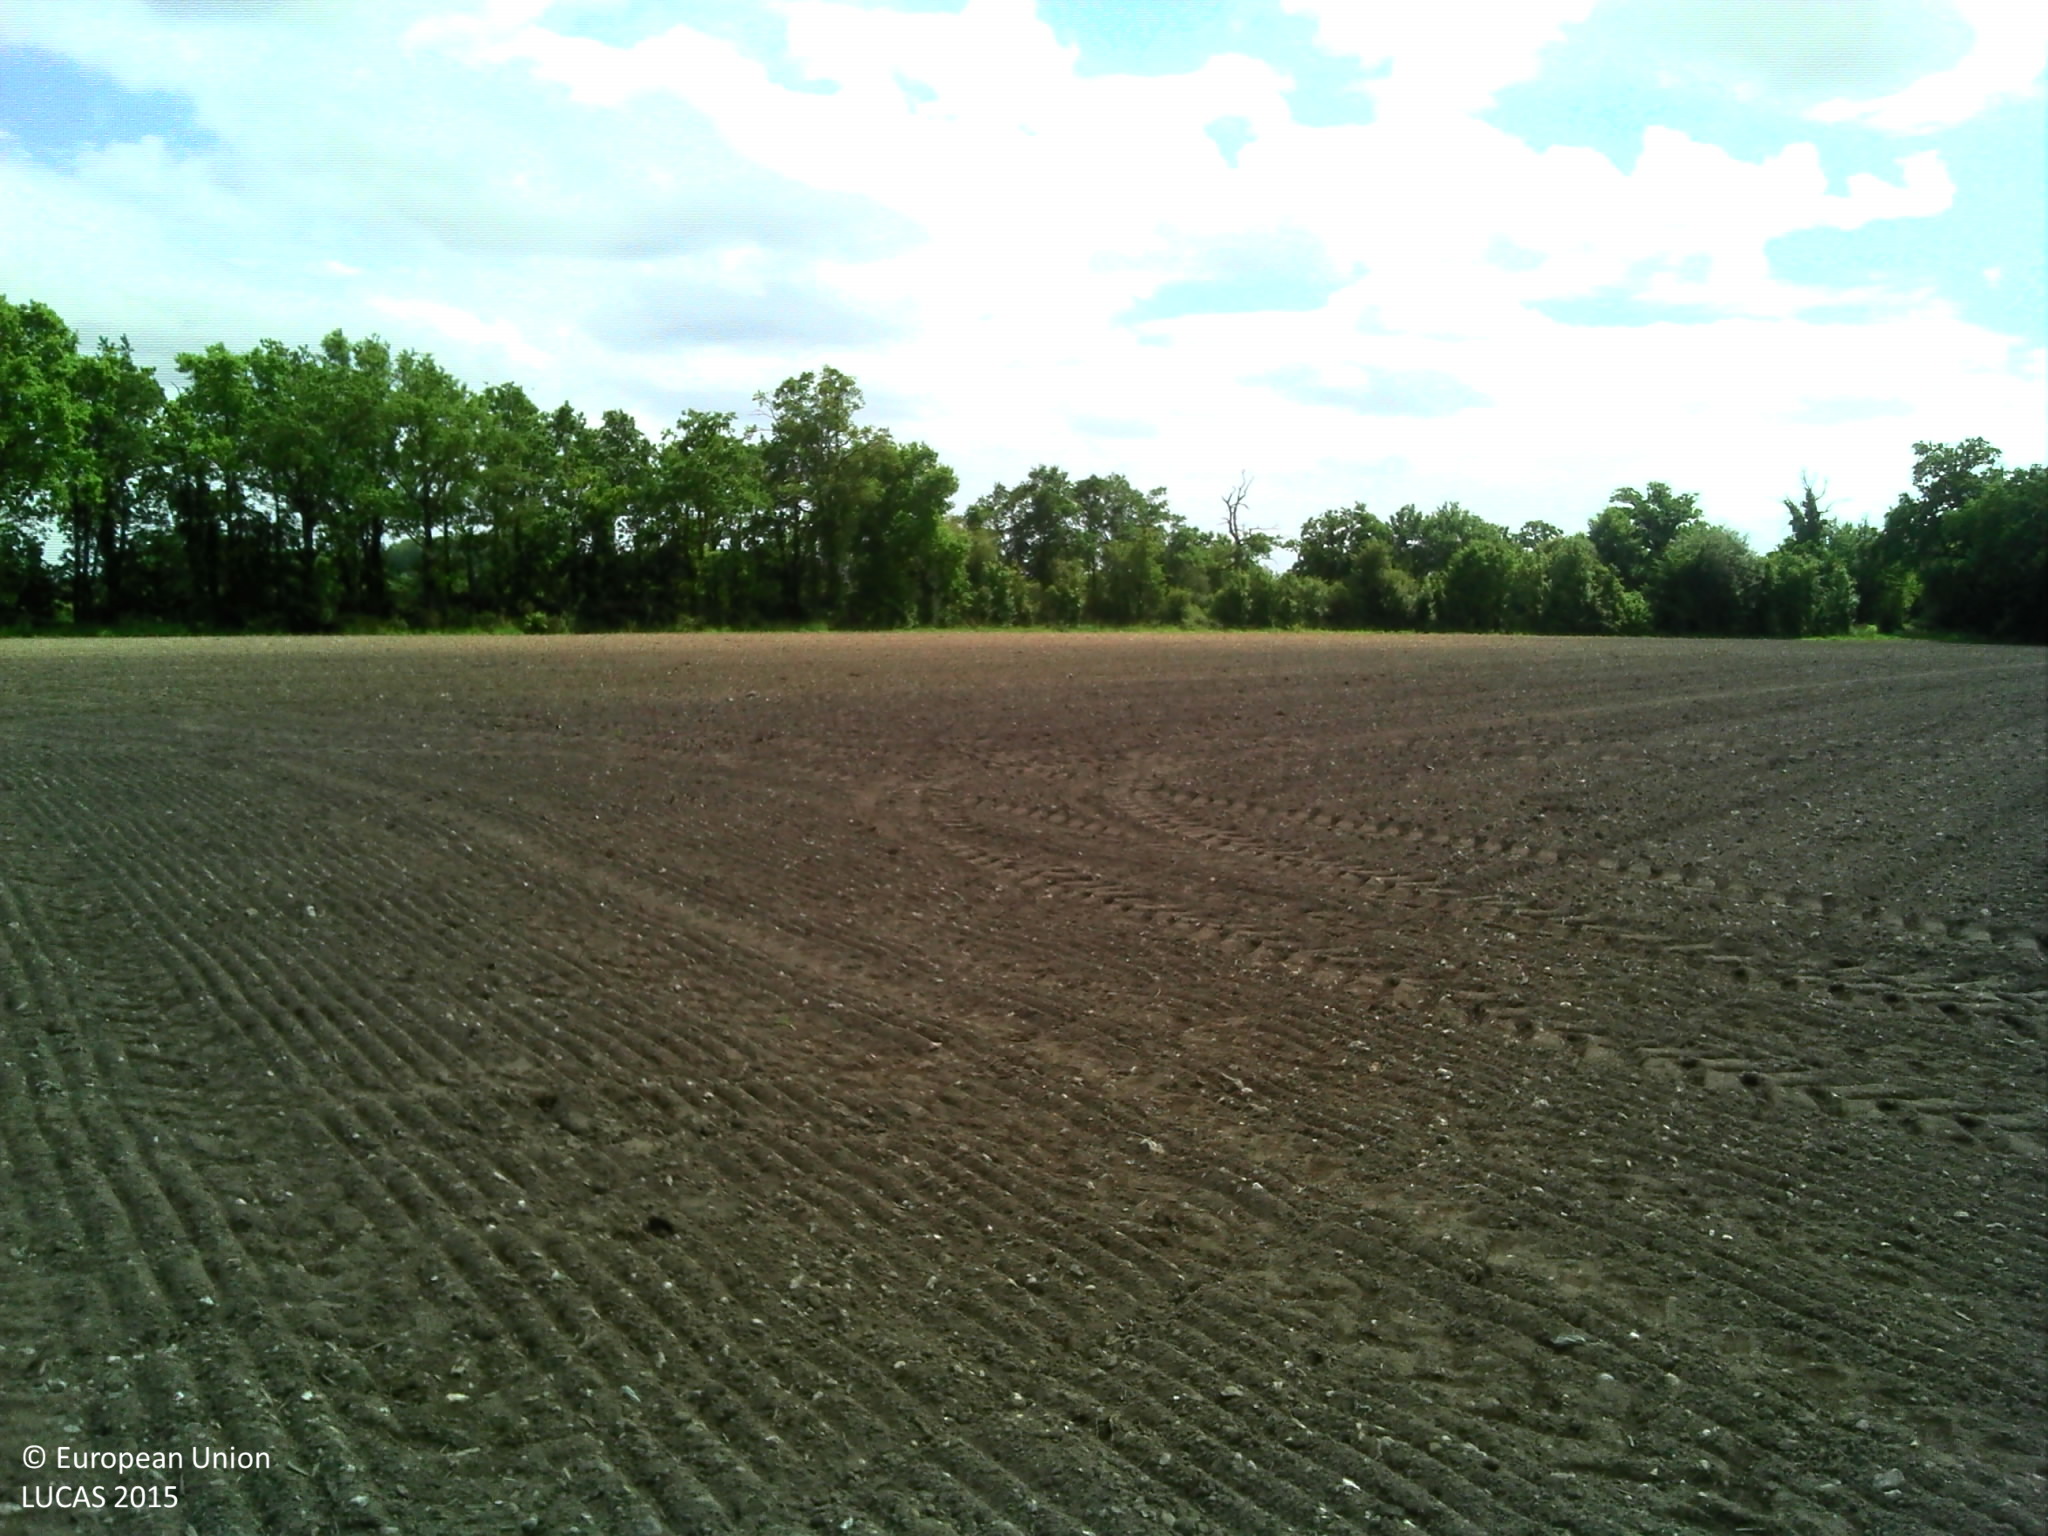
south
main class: Cropland
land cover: Maize
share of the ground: 10 - 25 %
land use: Agriculture (excluding fallow land and kitchen gardens)
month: June
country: FR
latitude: 46.8679
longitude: -1.8912
